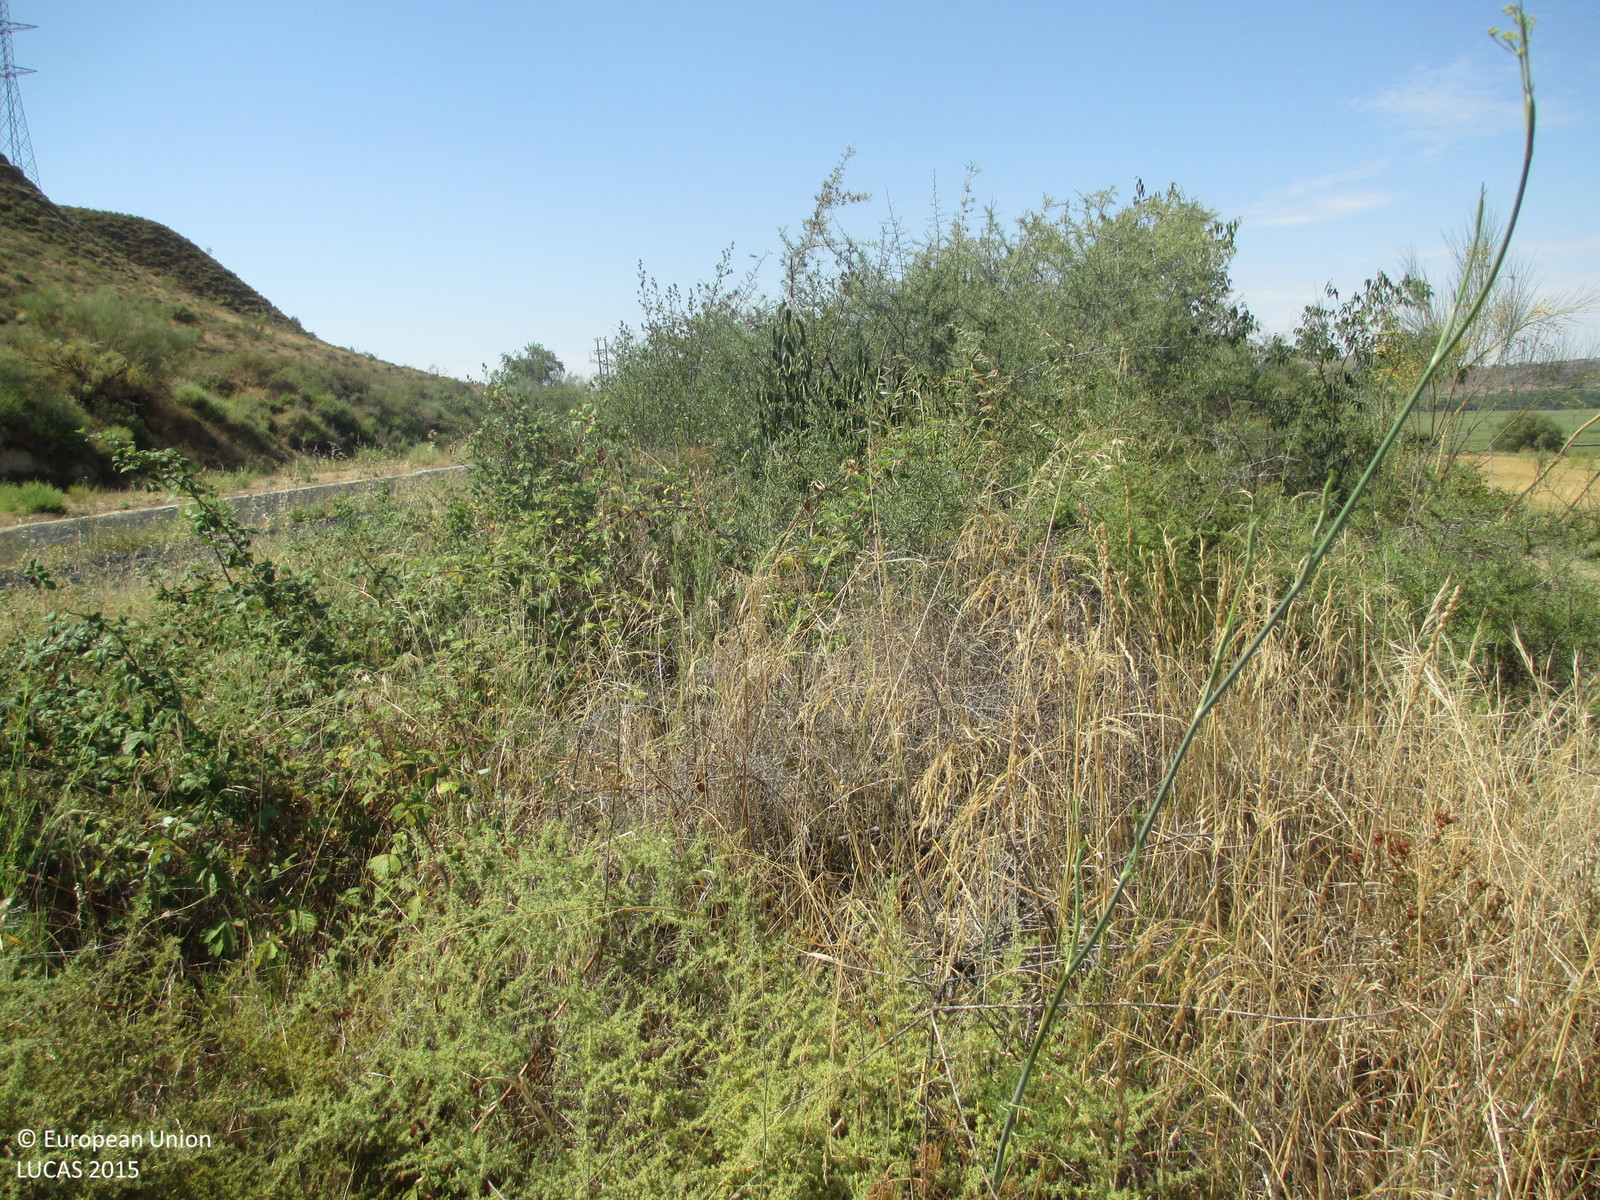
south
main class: Shrubland
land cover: Shrubland without tree cover
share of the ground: > 75 %
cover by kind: shrubs 95 %, herbaceous plants 5 %
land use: Semi-natural and natural areas not in use
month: July
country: ES
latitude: 41.9772
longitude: 0.1951
